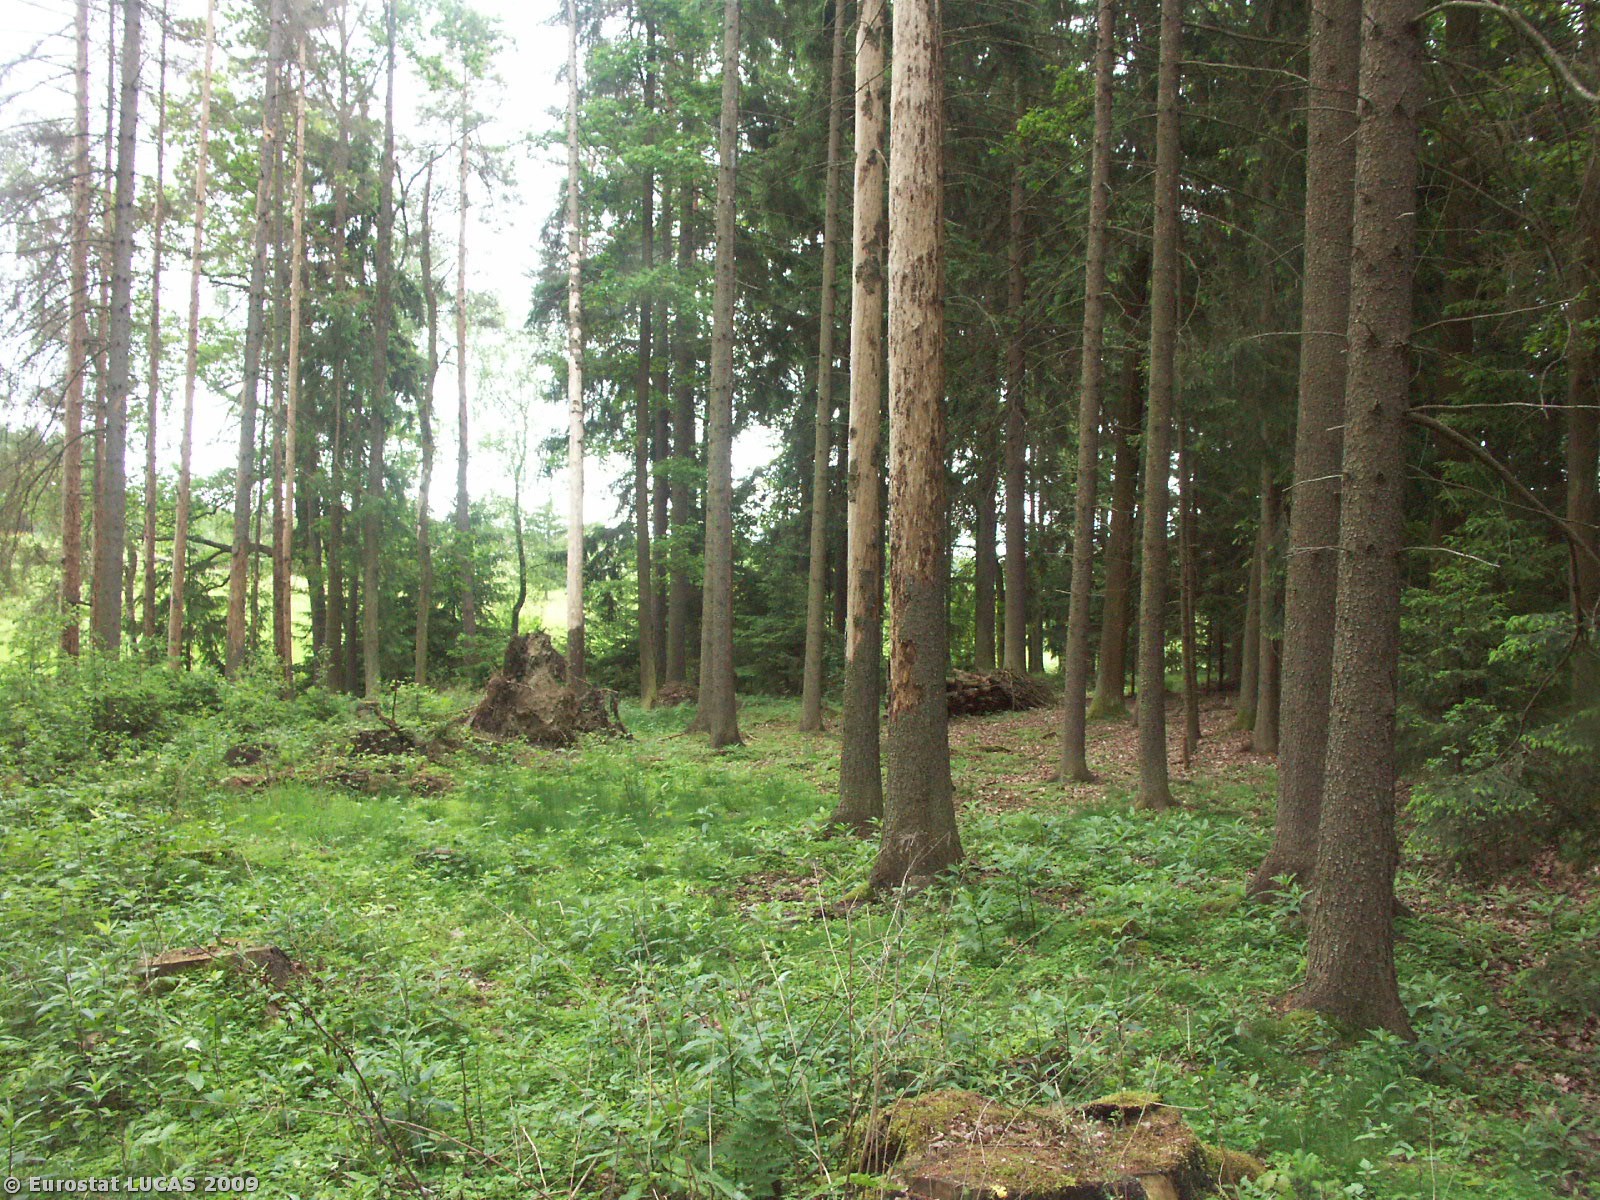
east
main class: Woodland
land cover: Mixed woodland
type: hemiboreal forest and nemoral coniferous forest and mixed broadleaved-coniferous forest
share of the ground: > 75 %
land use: Forestry
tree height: > 5 m
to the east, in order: Mixed woodland; Ditches and canals; Grassland without tree/shrub cover
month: May
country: CZ
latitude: 48.8644
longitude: 14.6497
